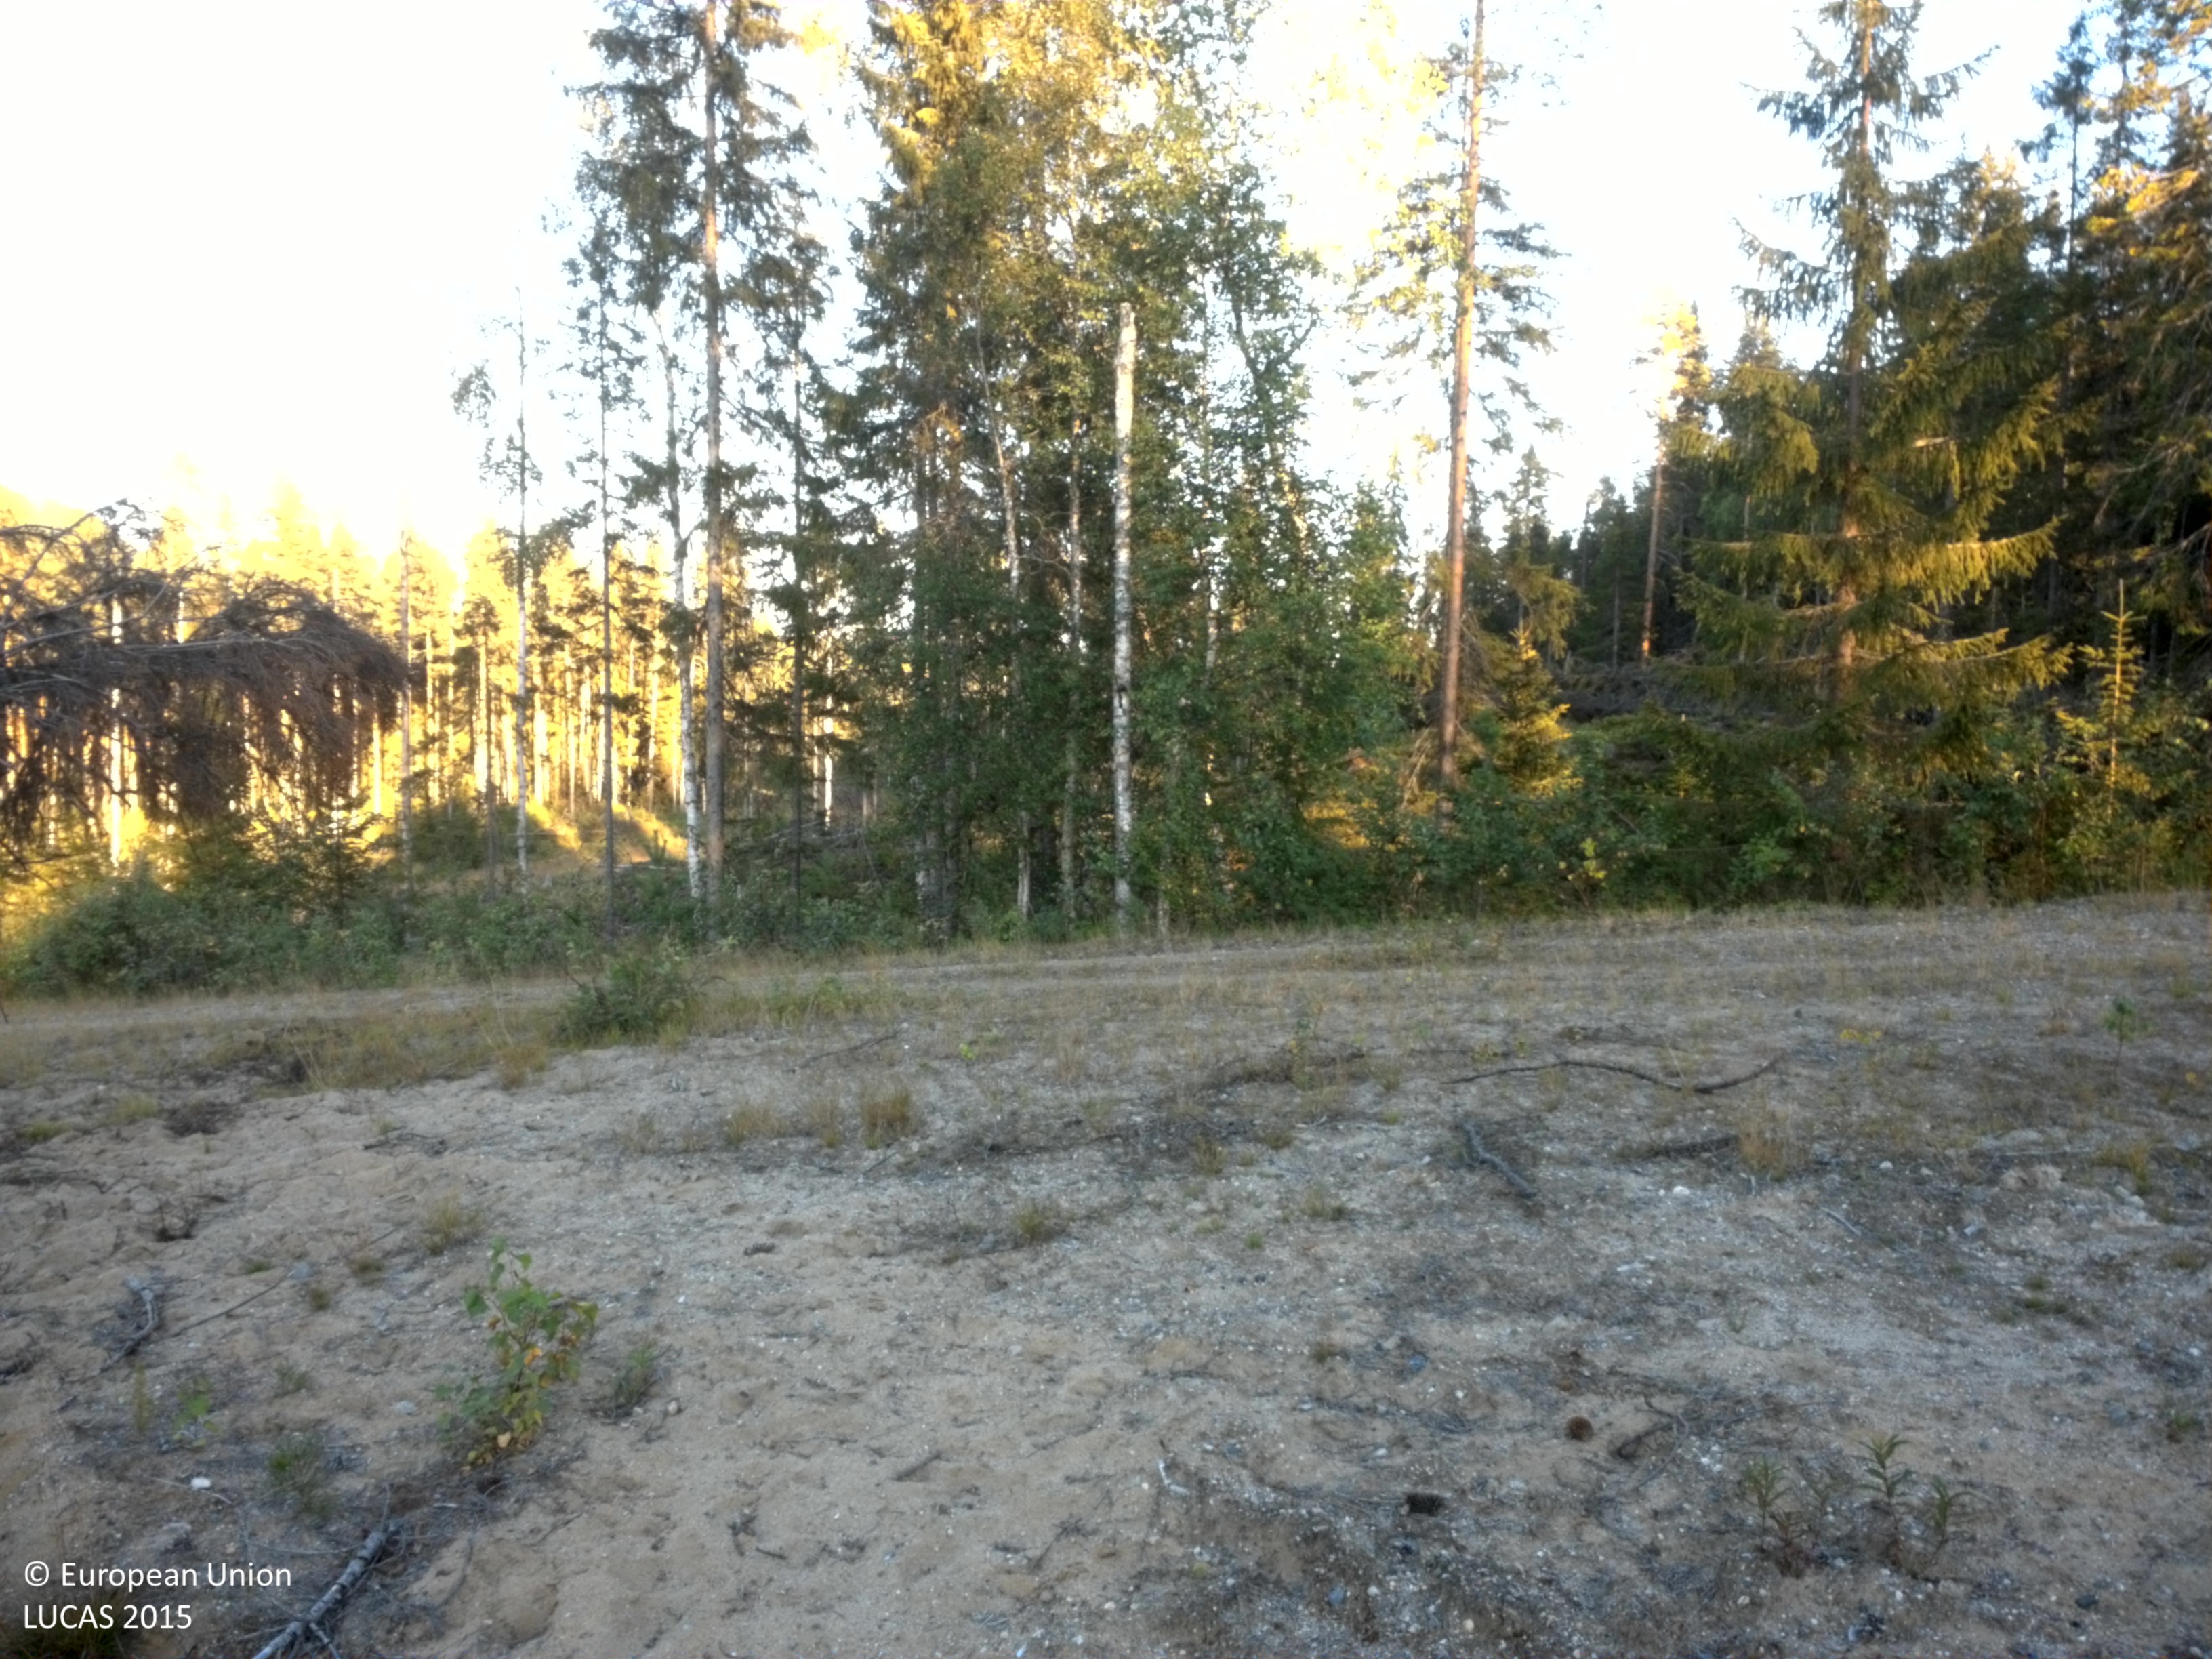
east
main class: Woodland
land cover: Other mixed woodland
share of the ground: 10 - 25 %
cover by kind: unconsolidated bare surface 60 %, herbaceous plants 20 %, broadleaved forest trees 10 %, coniferous forest trees 5 %, shrubs 5 %
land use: Forestry
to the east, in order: Other mixed woodland; Sand; Paved roads, cycling and walking lanes; Other mixed woodland; Shrubland without tree cover; Grassland without tree/shrub cover; Broadleaved woodland; Pine dominated coniferous woodland; Spruce dominated coniferous woodland; Grassland without tree/shrub cover; Shrubland without tree cover
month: August
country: SE
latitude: 64.4153
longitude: 18.9985
